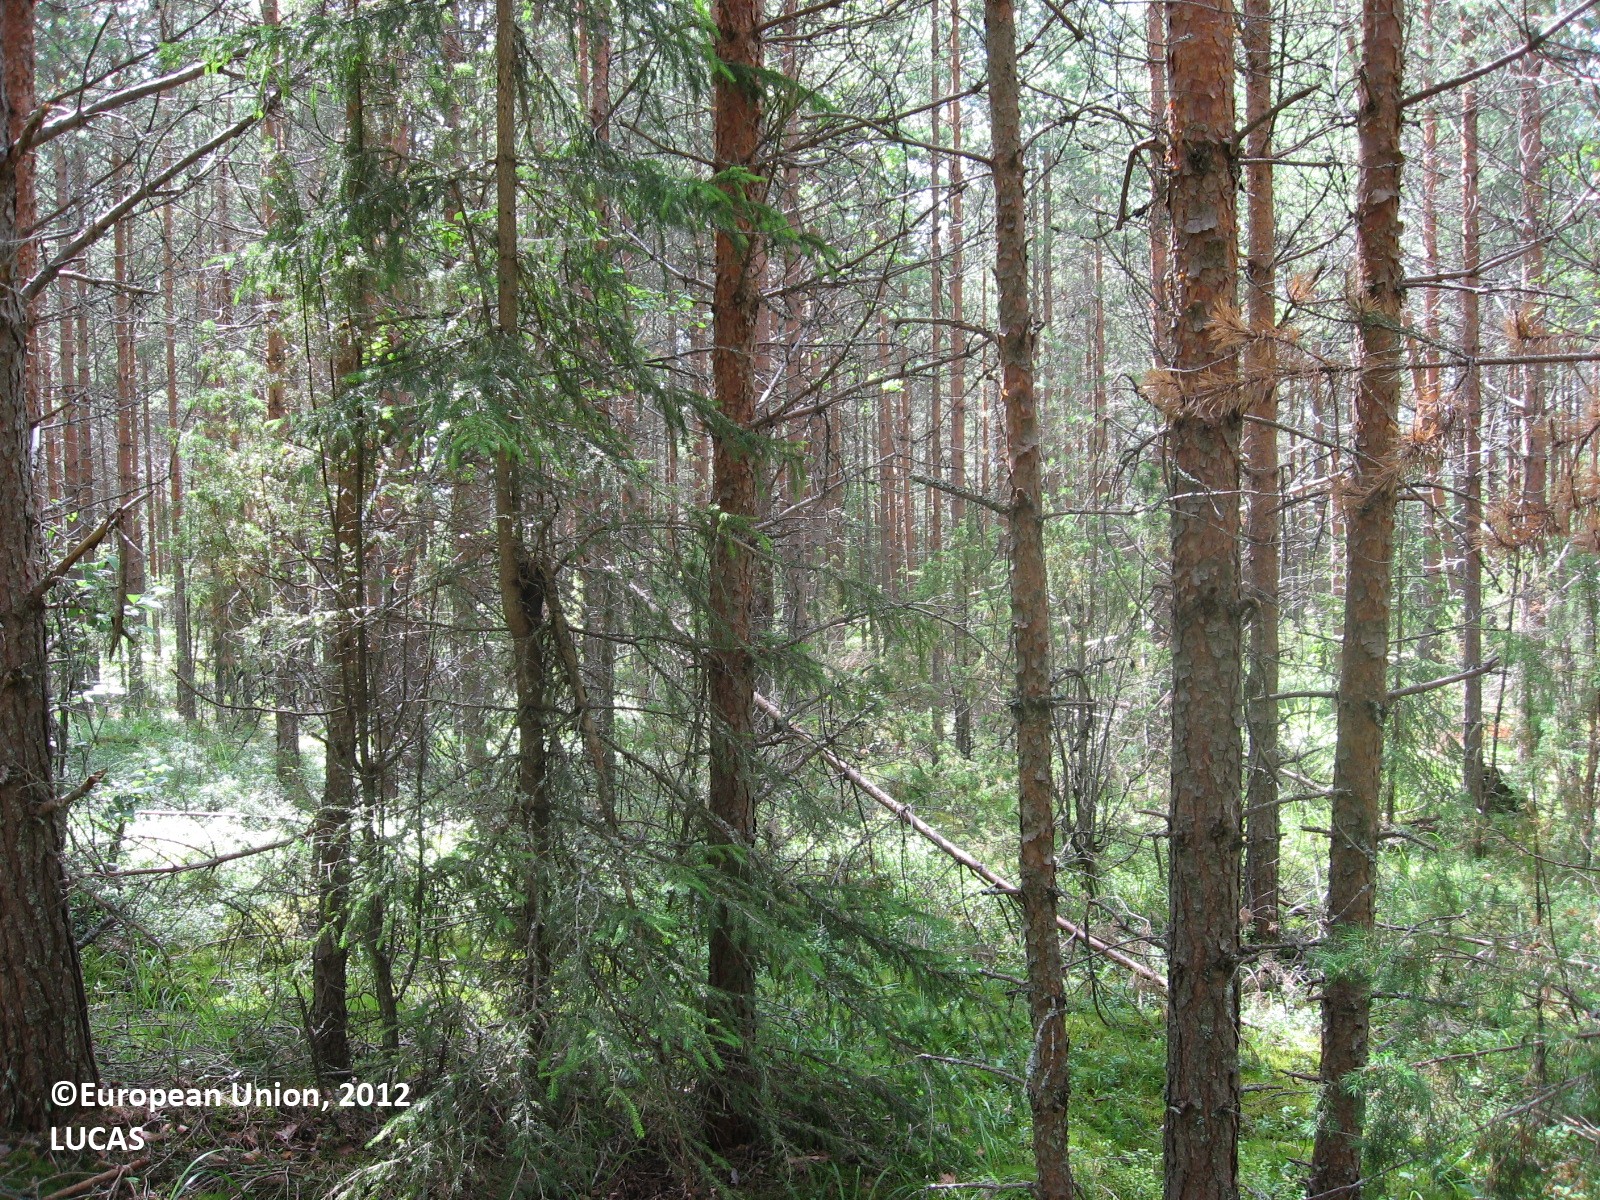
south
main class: Woodland
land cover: Pine dominated coniferous woodland
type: boreal forest
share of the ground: > 75 %
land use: Forestry
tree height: > 5 m
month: July
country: FI
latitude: 61.1223
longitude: 25.8174
